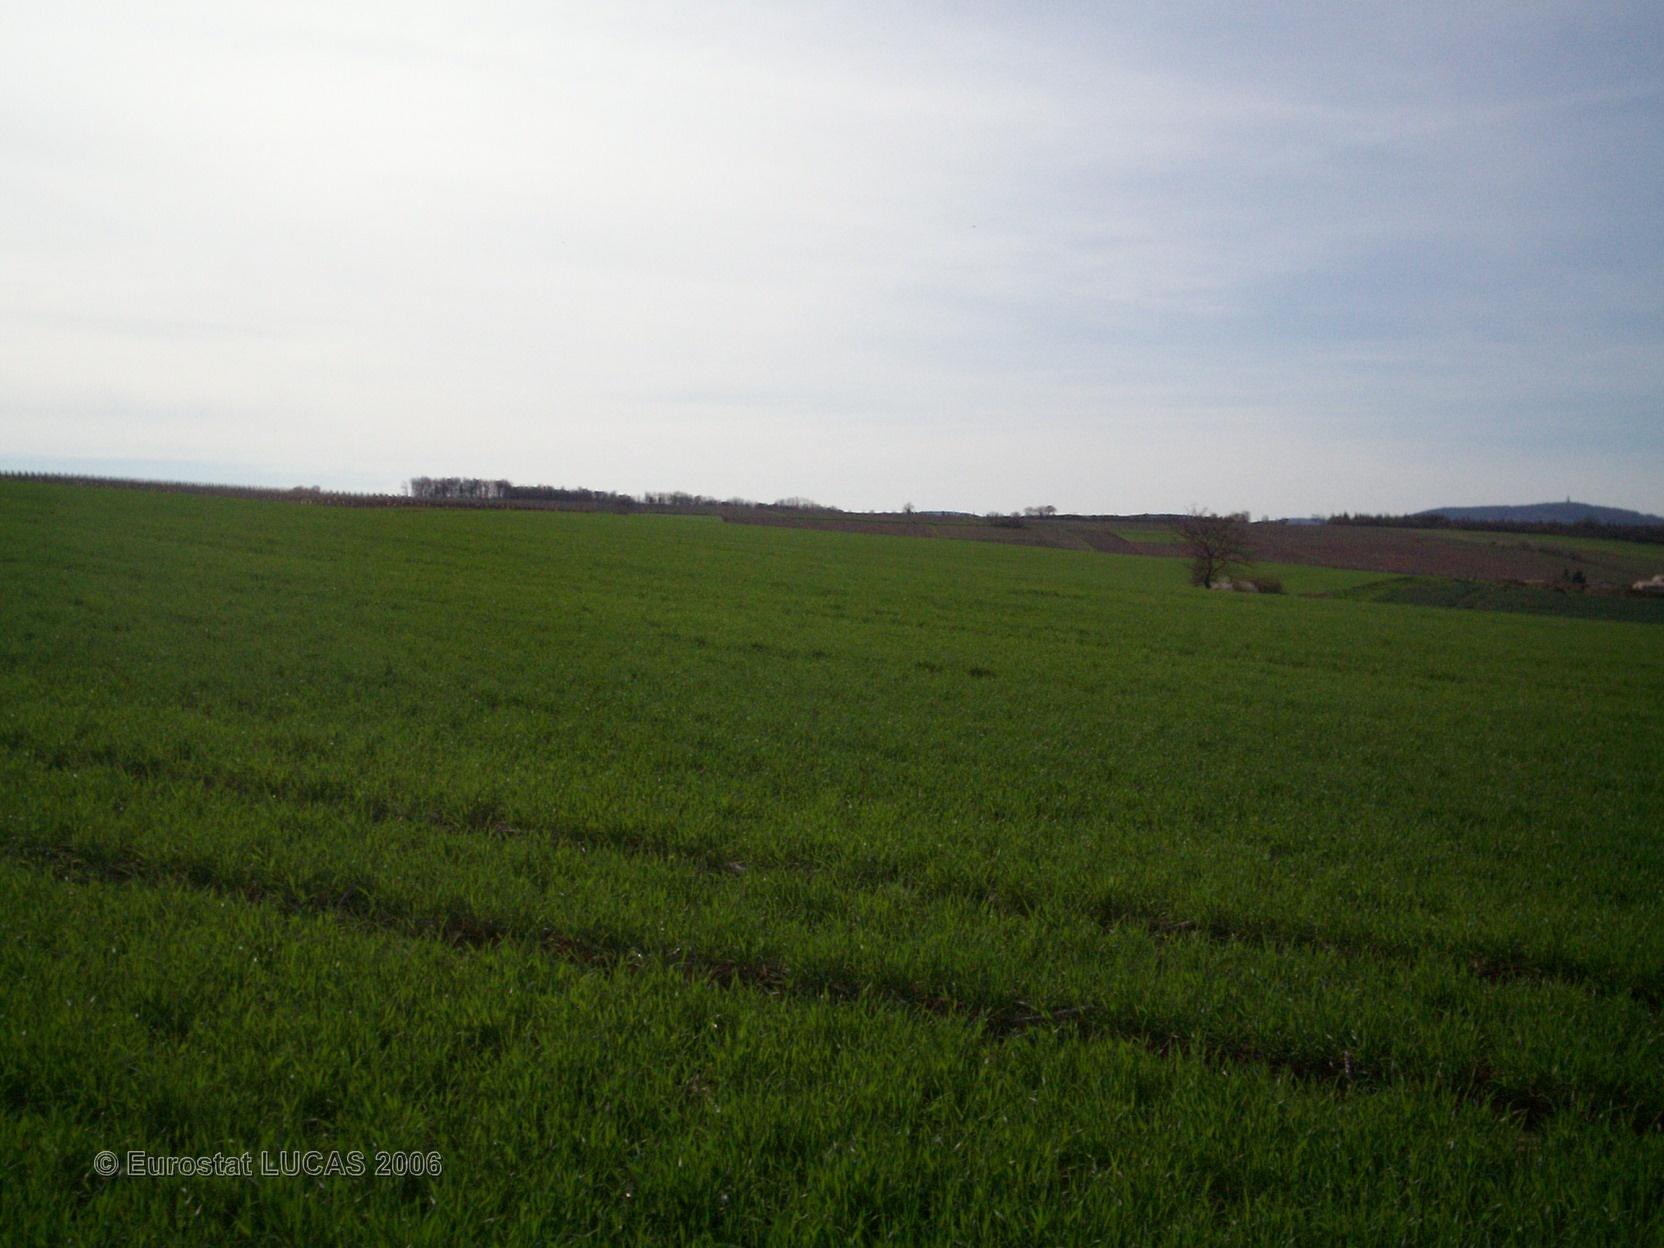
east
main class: Cropland
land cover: Common wheat
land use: Agriculture (excluding fallow land and kitchen gardens)
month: April
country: FR
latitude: 46.3879
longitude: 4.8137
